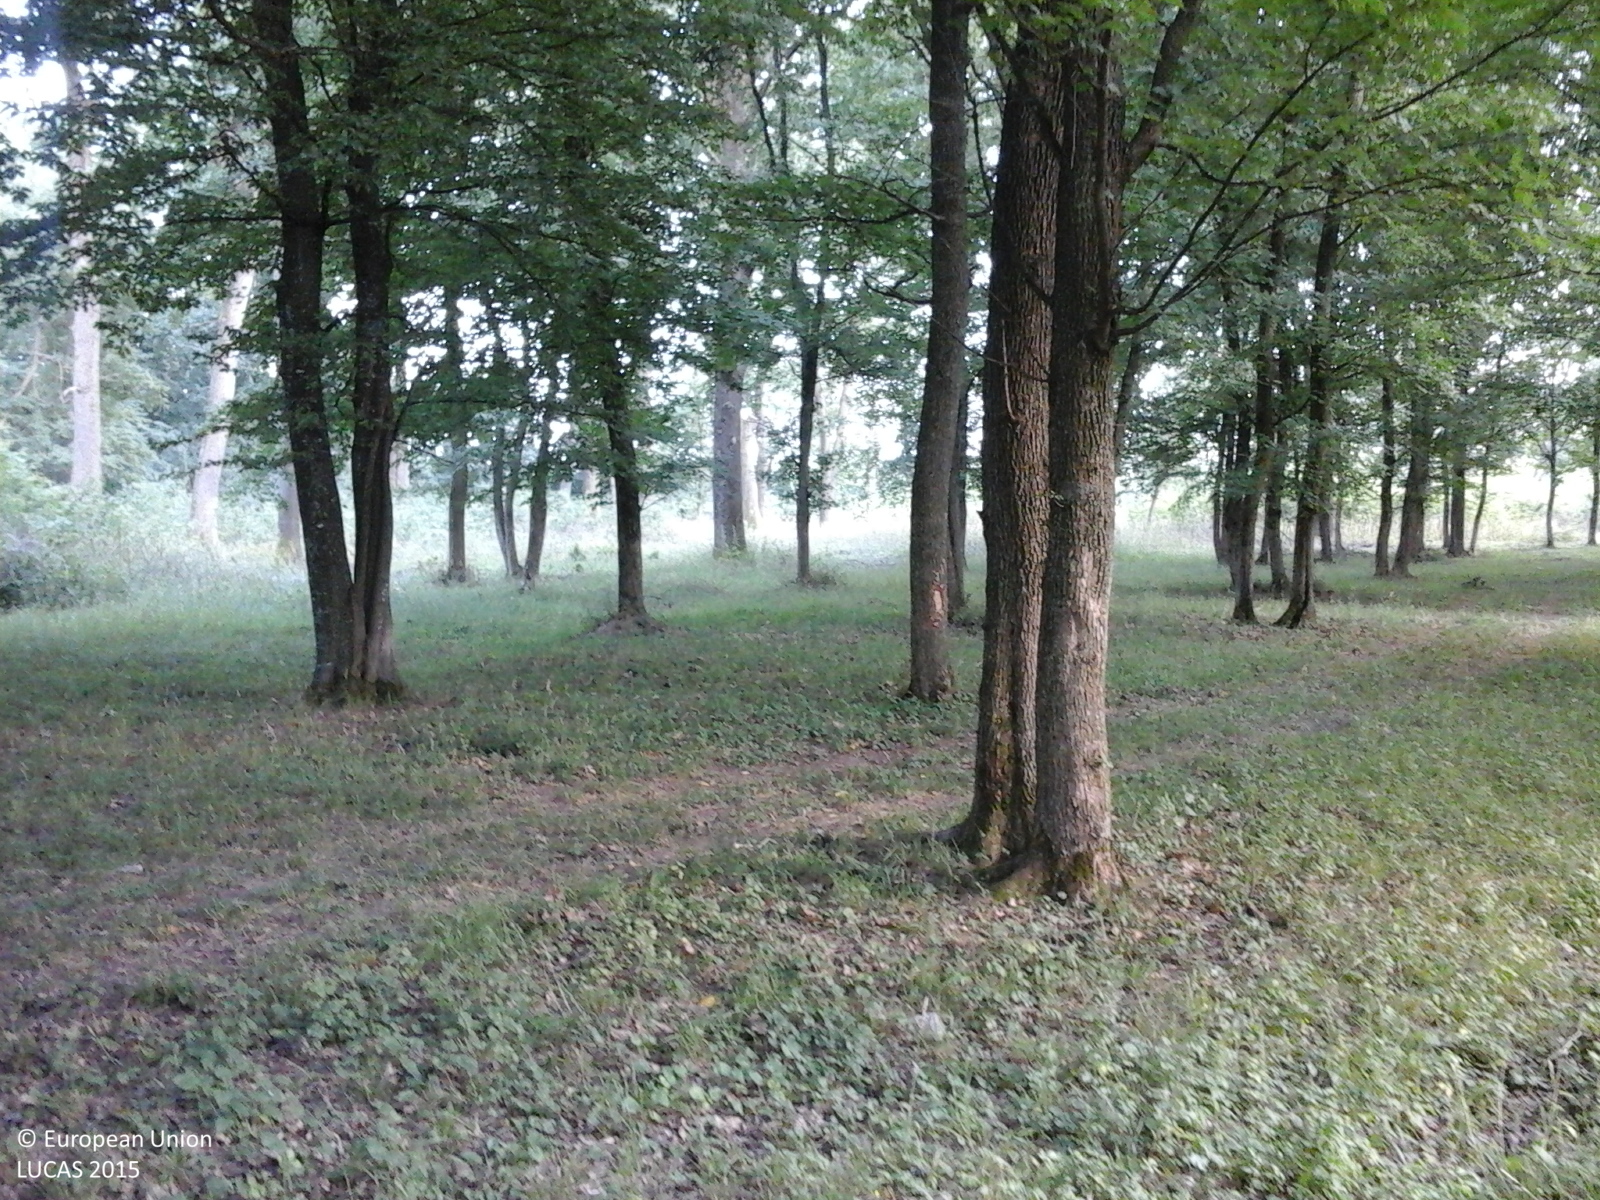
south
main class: Woodland
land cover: Broadleaved woodland
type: mesophytic deciduous forest
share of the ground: > 75 %
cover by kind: broadleaved forest trees 80 %, herbaceous plants 20 %
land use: Forestry
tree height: > 5 m
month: July
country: RO
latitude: 44.1835
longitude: 24.8998
